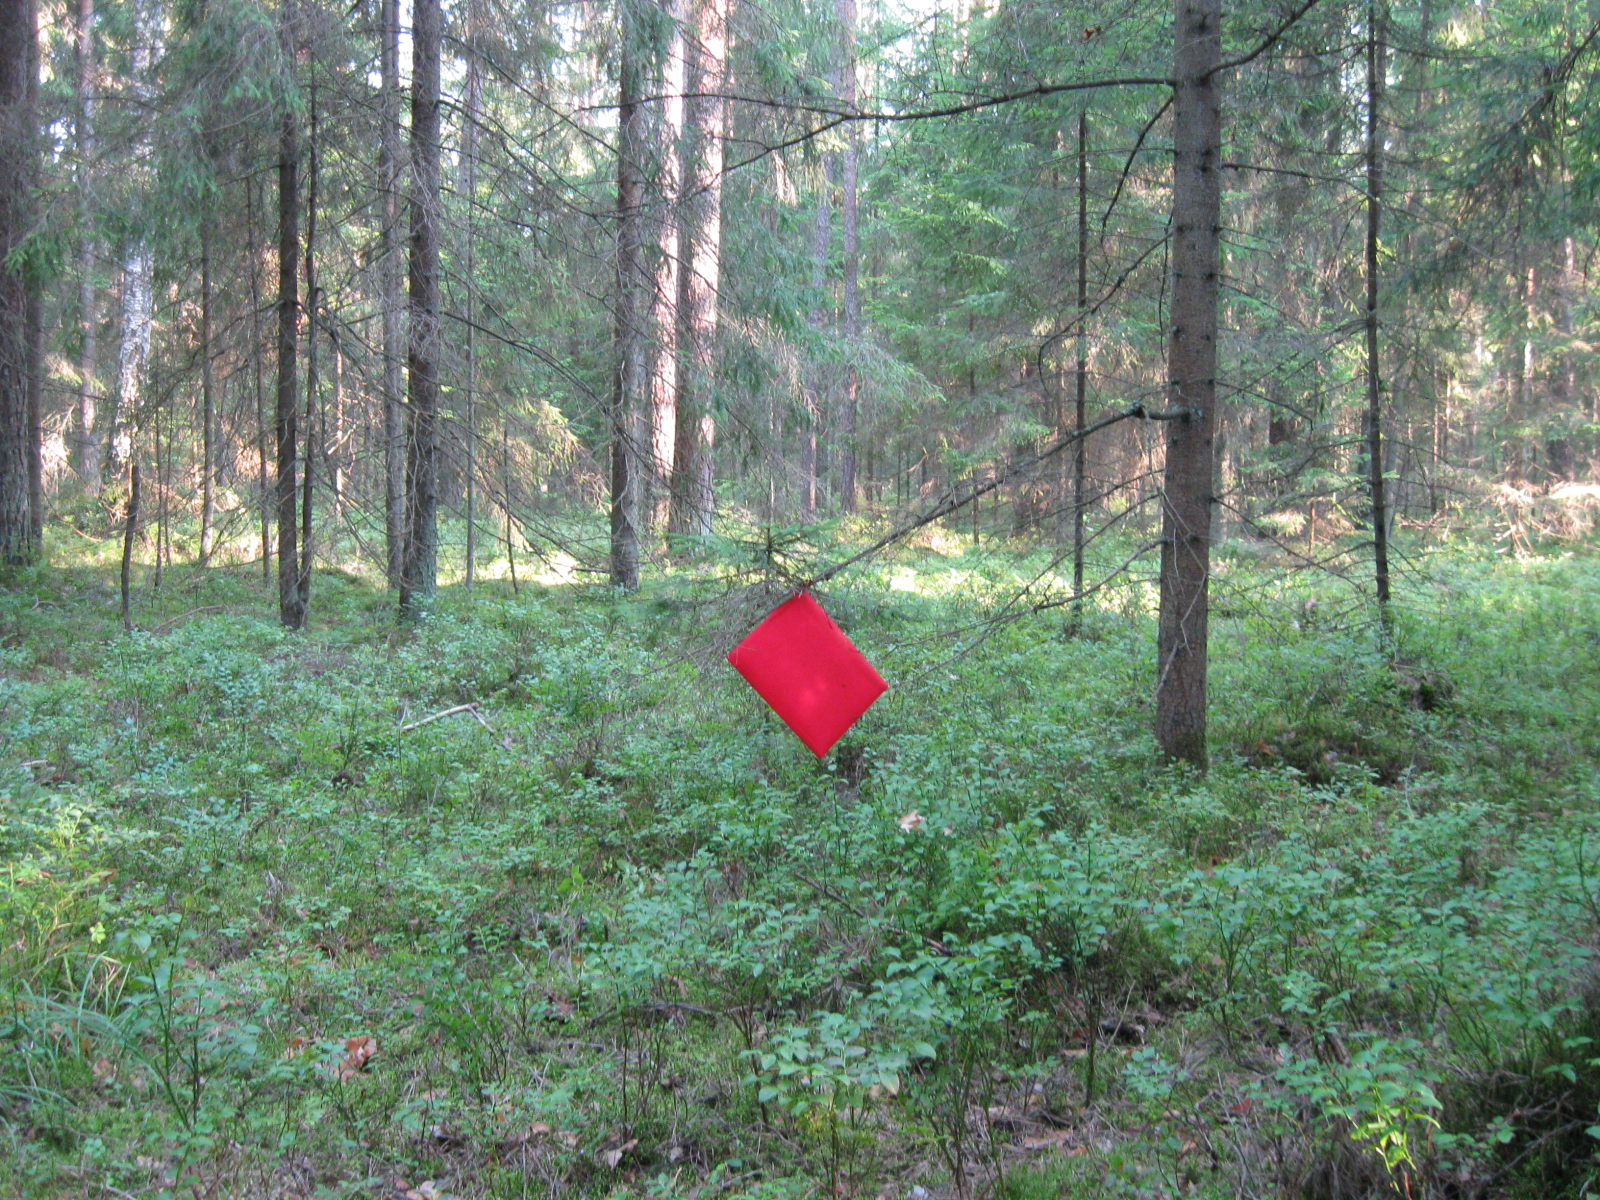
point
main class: Woodland
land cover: Other coniferous woodland
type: hemiboreal forest and nemoral coniferous forest and mixed broadleaved-coniferous forest
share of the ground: > 75 %
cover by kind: coniferous forest trees 85 %, shrubs 10 %, lichens and mosses 5 %
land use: Forestry
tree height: > 5 m
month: August
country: LT
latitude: 54.8459
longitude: 23.3624
